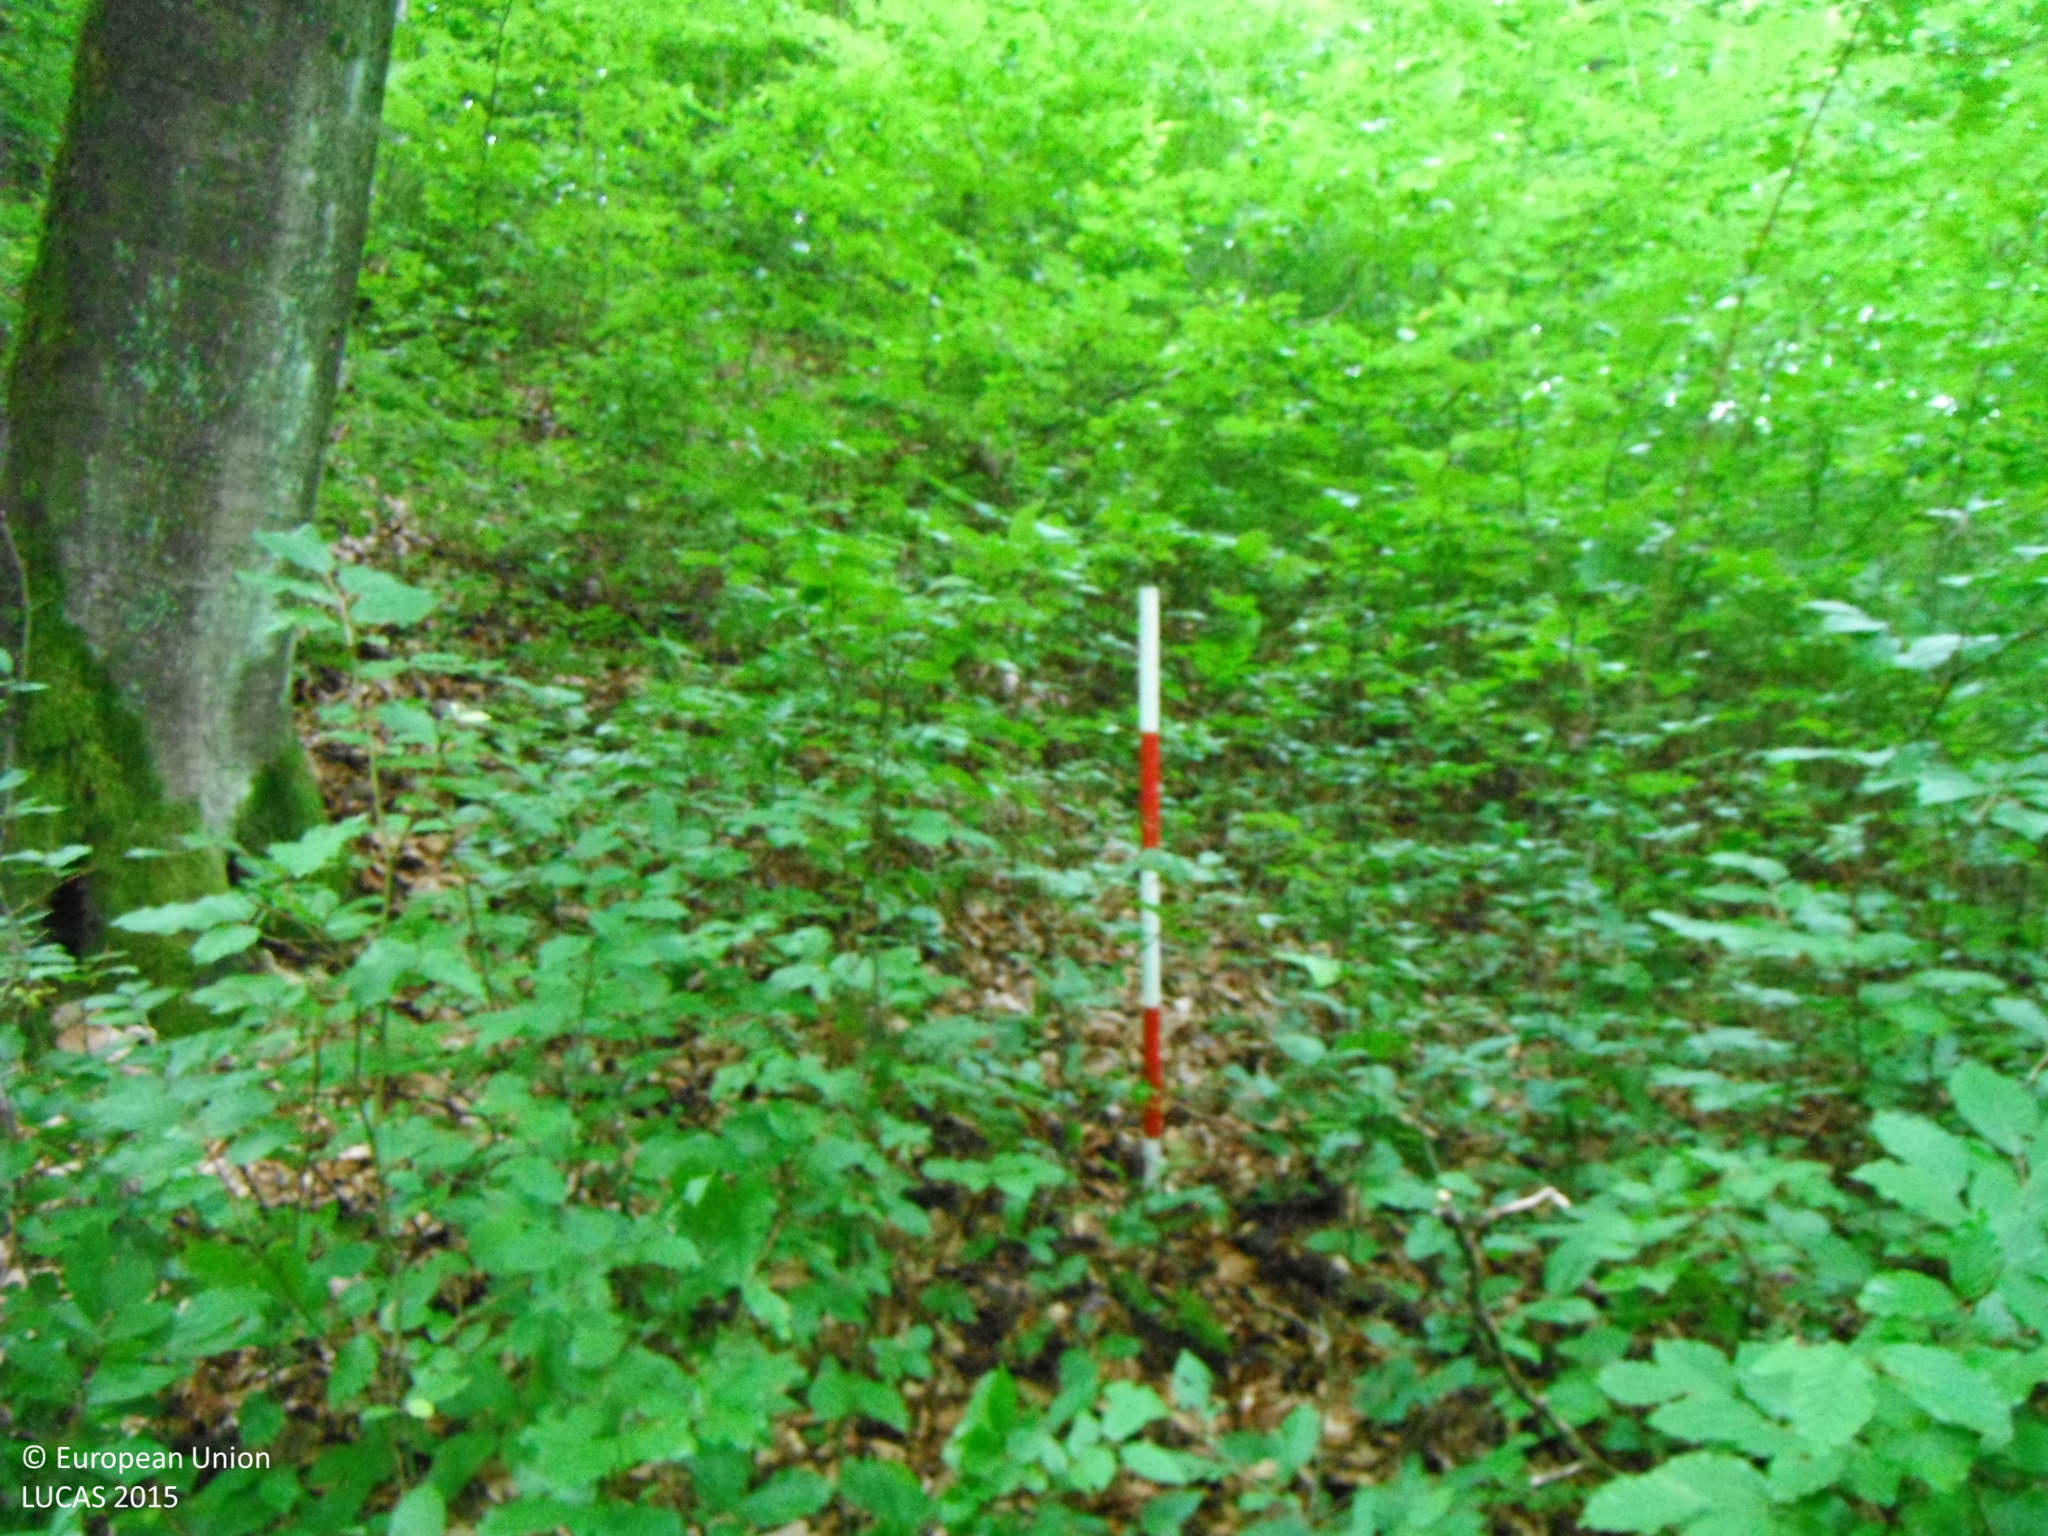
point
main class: Woodland
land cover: Broadleaved woodland
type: beech forest
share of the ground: > 75 %
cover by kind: broadleaved forest trees 100 %
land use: Forestry
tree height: > 5 m
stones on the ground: 25 - 50 %
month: June
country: SK
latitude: 48.5056
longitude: 20.0598
